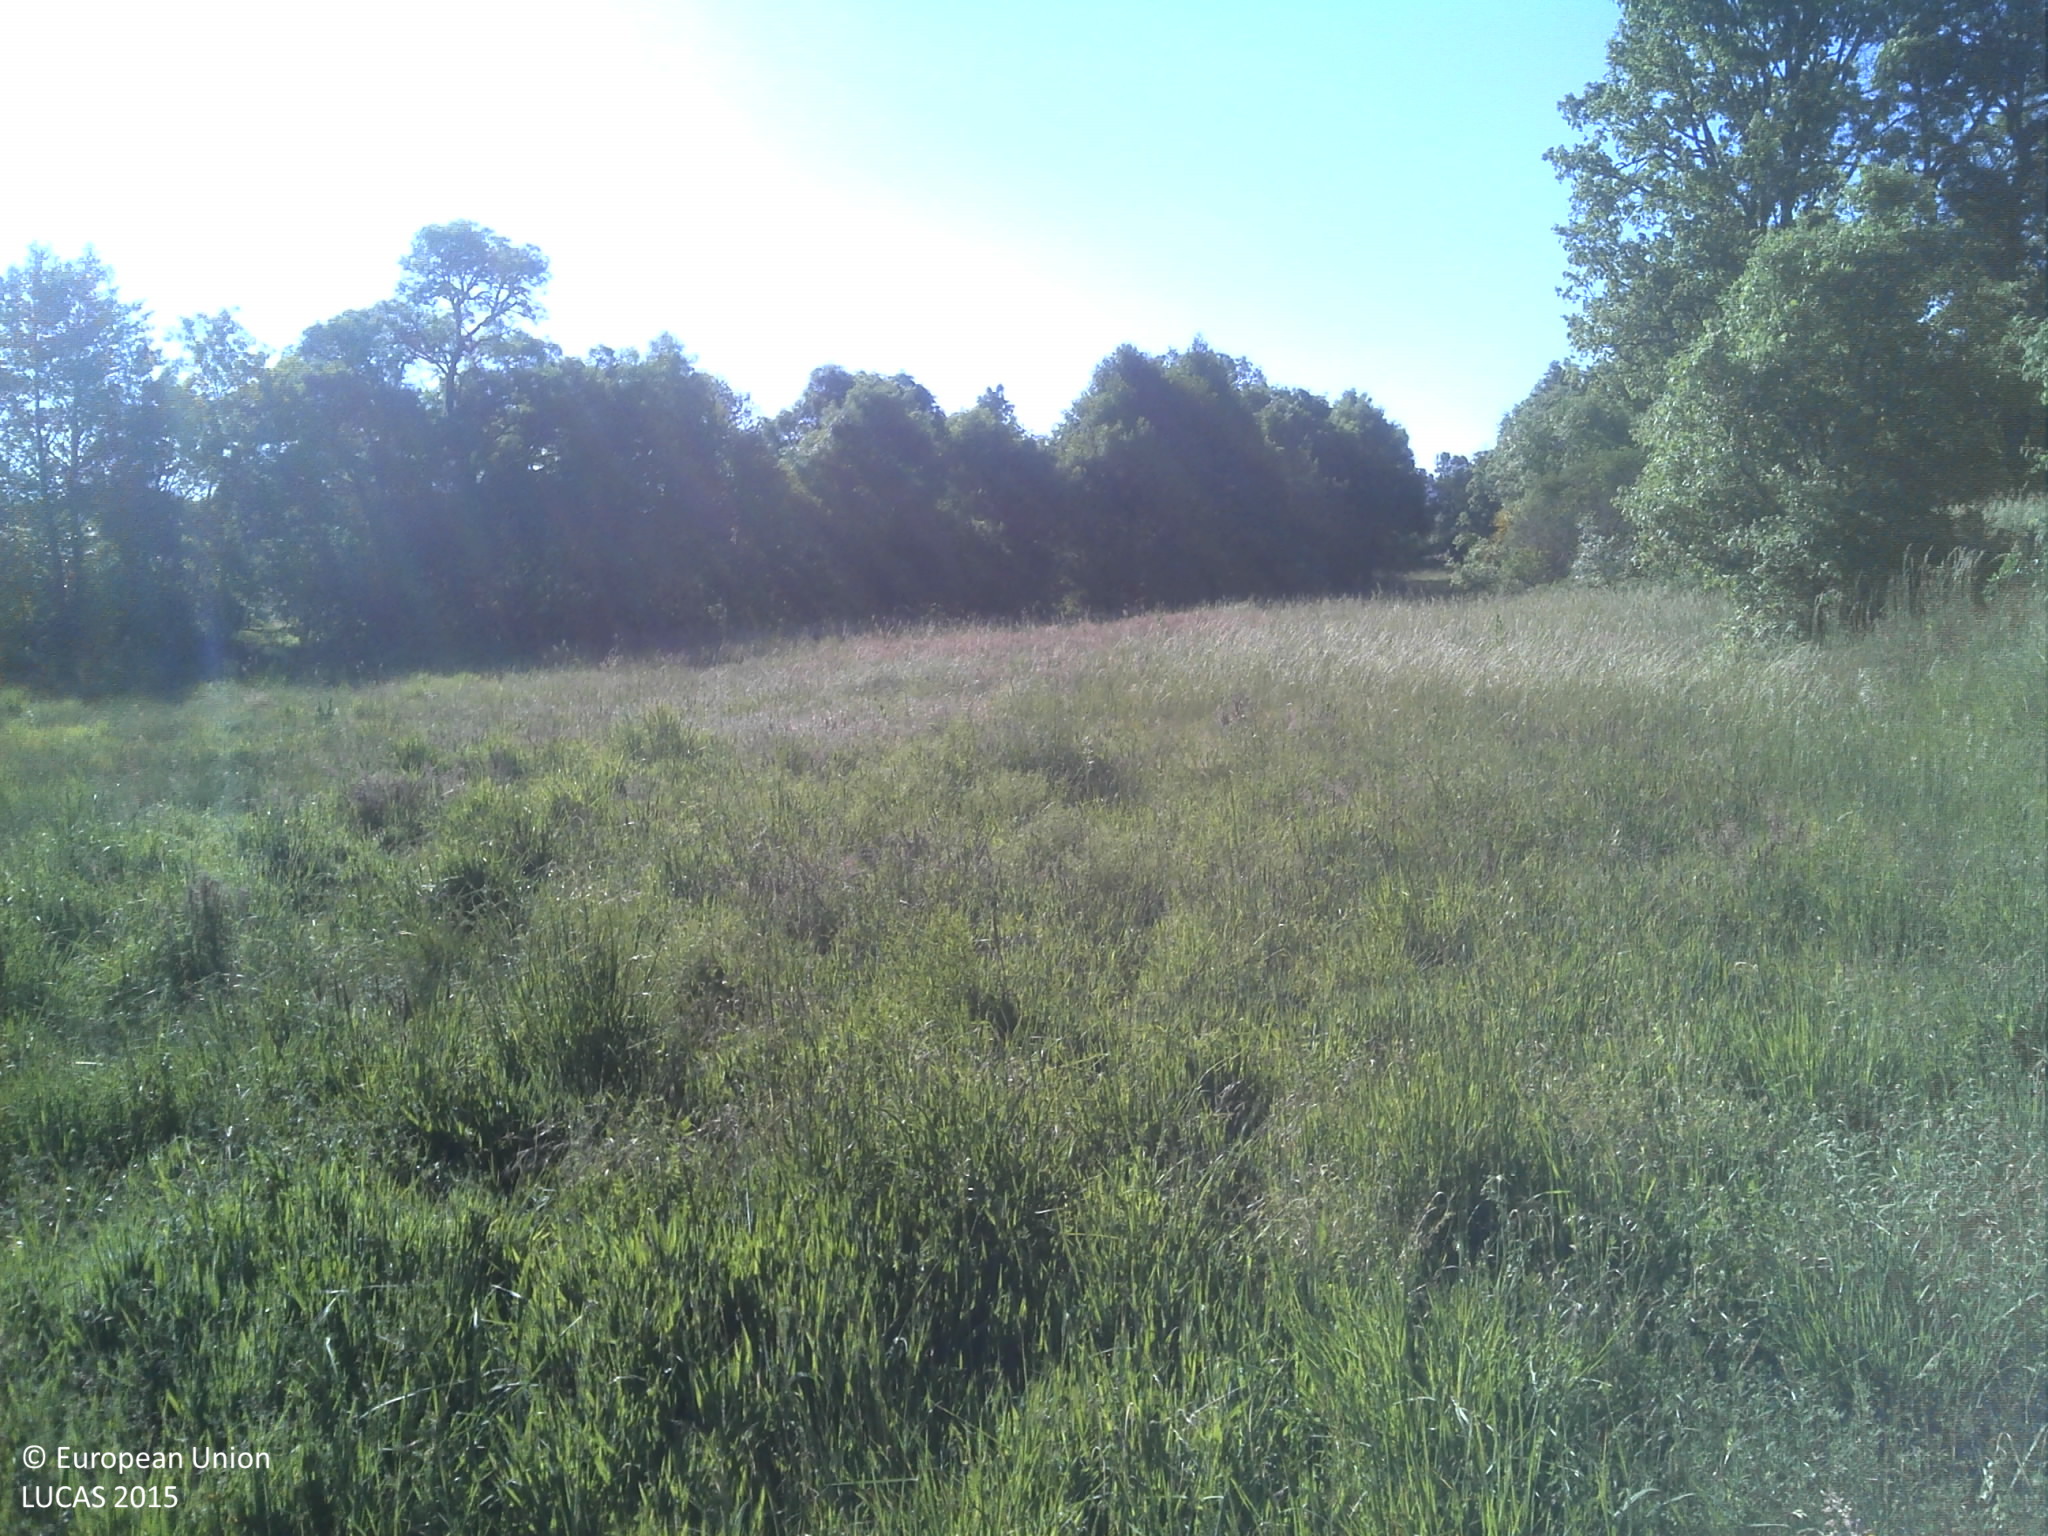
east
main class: Grassland
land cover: Grassland with sparse tree/shrub cover
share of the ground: 25 - 50 %
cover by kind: herbaceous plants 65 %, unconsolidated bare surface 25 %, broadleaved forest trees 5 %, shrubs 5 %
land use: Agriculture (excluding fallow land and kitchen gardens)
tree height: < 5 m
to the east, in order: Grassland with sparse tree/shrub cover; Abandoned hedges; Rivers and streams; Abandoned hedges; Grassland with sparse tree/shrub cover; Tracks; Grassland with sparse tree/shrub cover
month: May
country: PT
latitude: 40.6448
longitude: -7.1448
